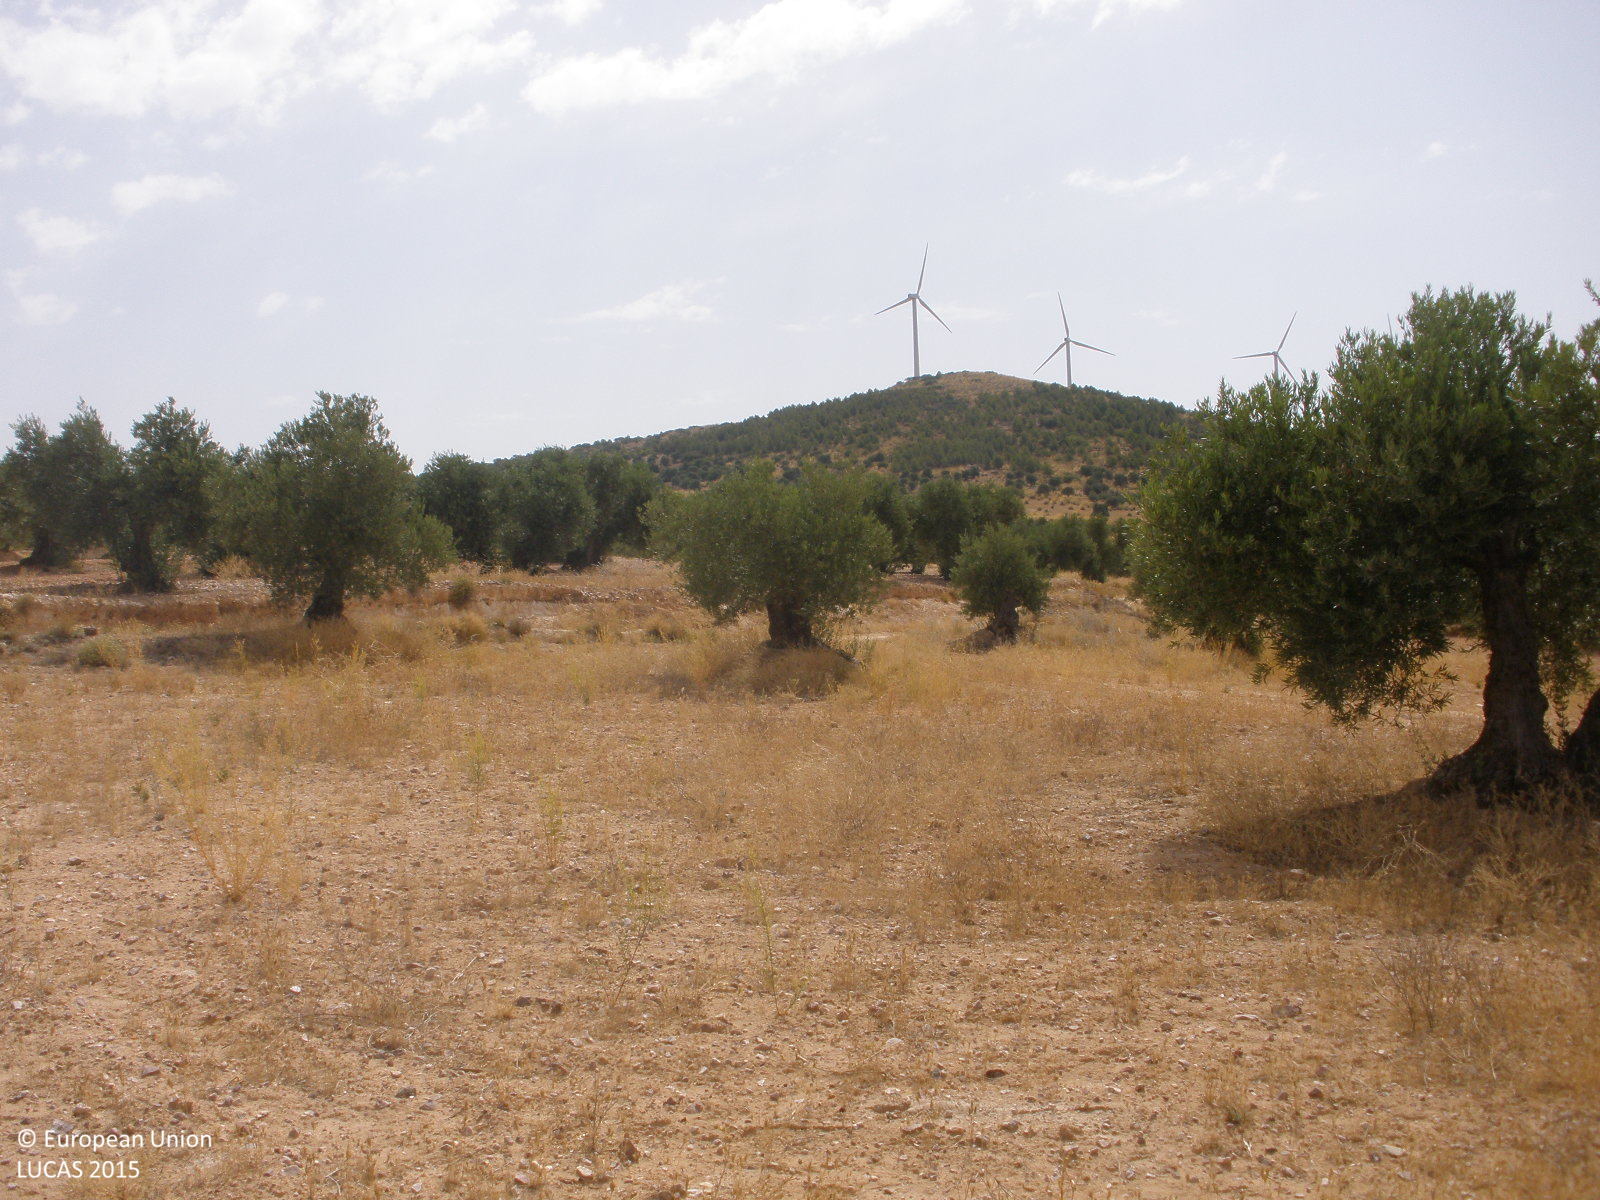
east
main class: Cropland
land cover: Olive groves
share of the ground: 25 - 50 %
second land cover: Spontaneously vegetated surfaces
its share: 50 - 75 %
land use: Agriculture (excluding fallow land and kitchen gardens)
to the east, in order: Olive groves; Spontaneously vegetated surfaces; Tracks; Olive groves; Grass margins; Olive groves; Grass margins; Olive groves; Grass margins; Olive groves
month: July
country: ES
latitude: 39.6706
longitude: -3.4185
